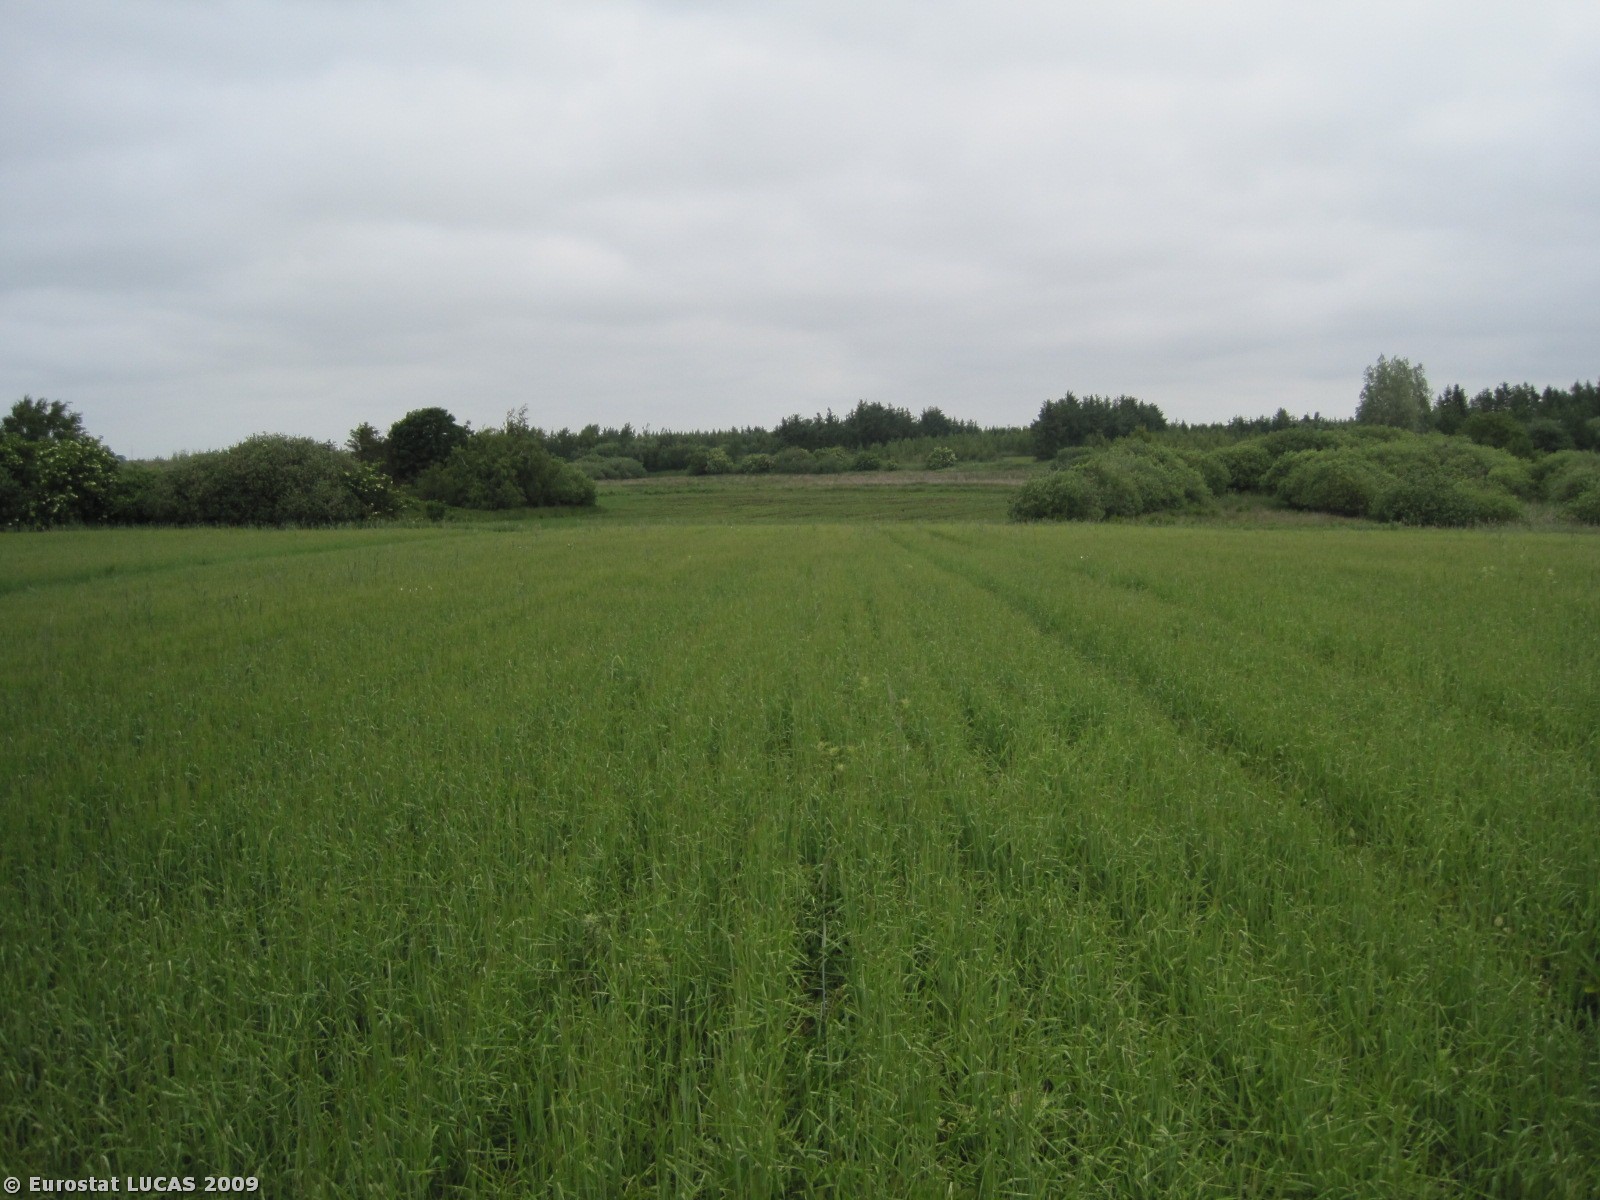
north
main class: Cropland
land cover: Barley
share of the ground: > 75 %
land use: Agriculture (excluding fallow land and kitchen gardens)
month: June
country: DK
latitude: 57.1944
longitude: 10.0826
